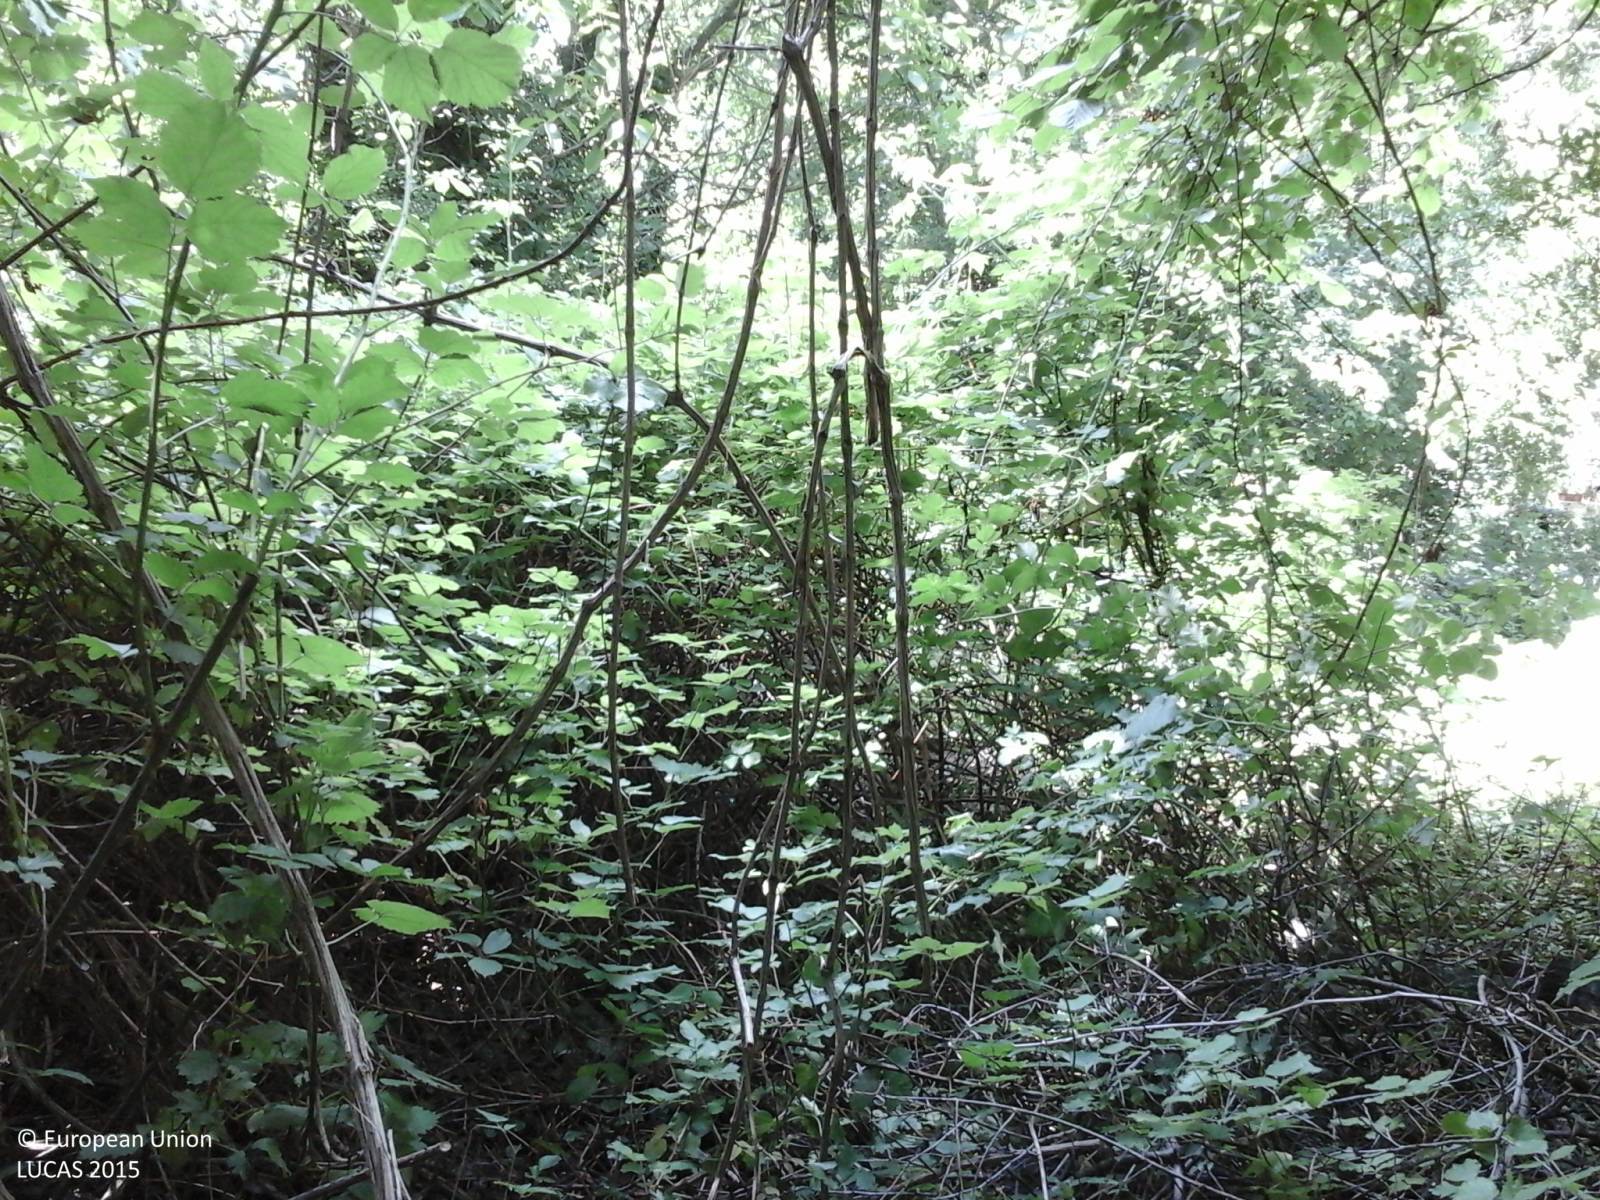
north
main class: Woodland
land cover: Broadleaved woodland
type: thermophilous deciduous forest
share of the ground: > 75 %
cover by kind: broadleaved forest trees 80 %, shrubs 20 %
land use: Semi-natural and natural areas not in use
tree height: > 5 m
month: June
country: IT
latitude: 45.7863
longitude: 13.5846
